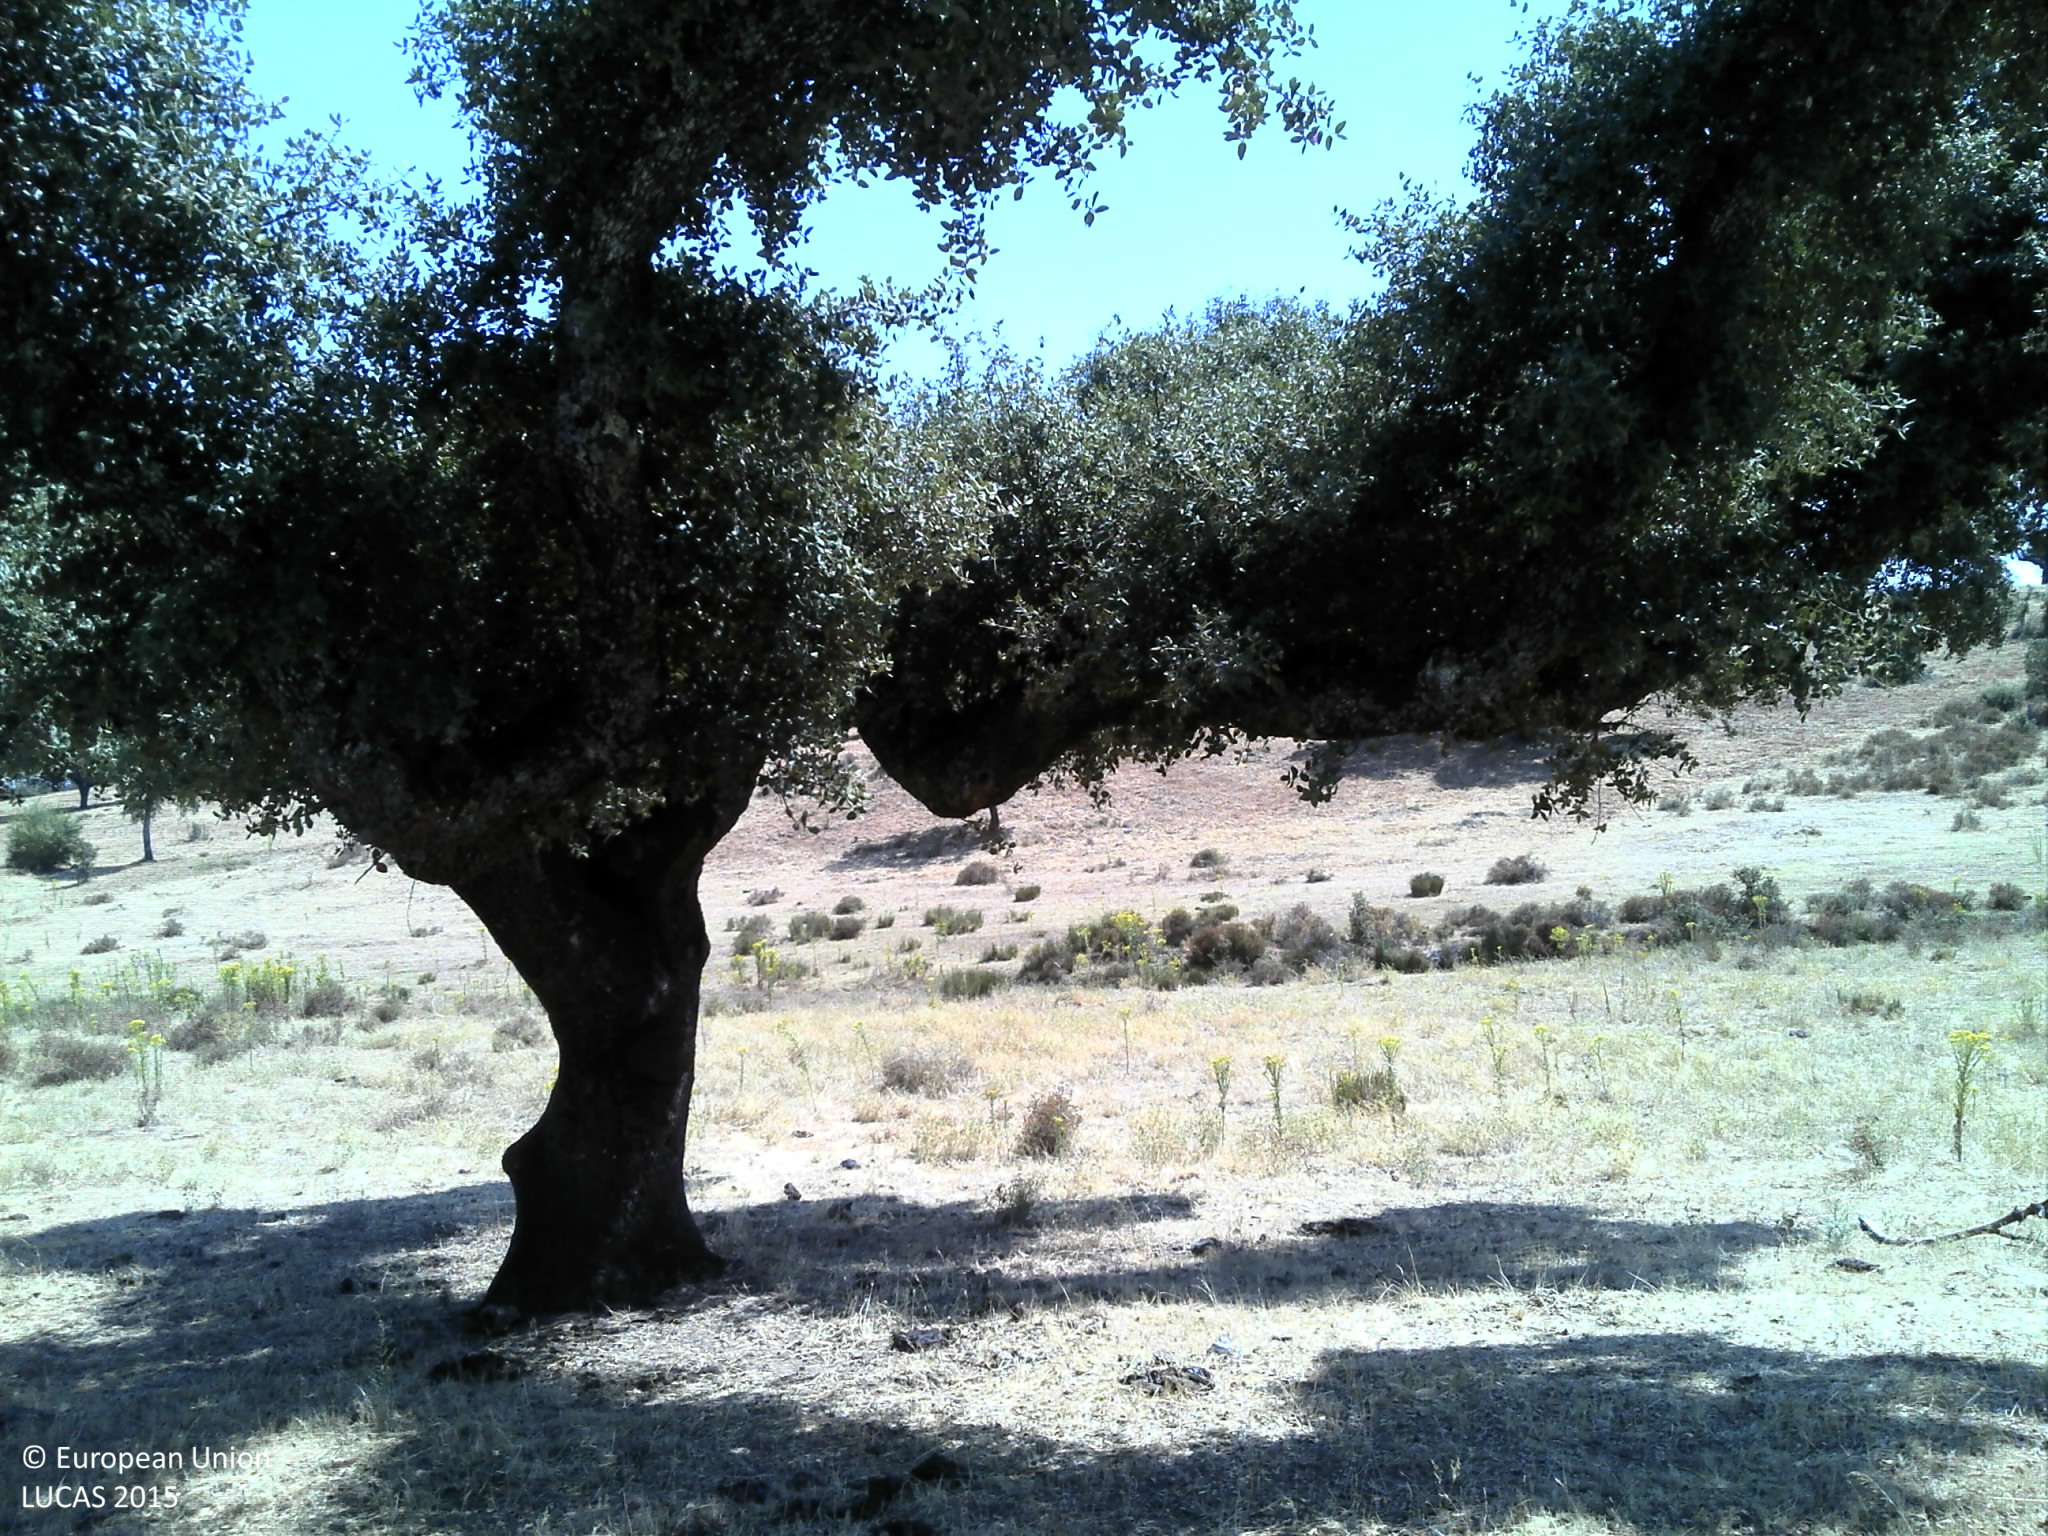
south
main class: Woodland
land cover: Broadleaved woodland
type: broadleaved evergreen forest
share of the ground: 25 - 50 %
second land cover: Grassland without tree/shrub cover
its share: 10 - 25 %
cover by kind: unconsolidated bare surface 50 %, broadleaved forest trees 25 %, herbaceous plants 25 %
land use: Forestry
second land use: Agriculture (excluding fallow land and kitchen gardens)
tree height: > 5 m
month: July
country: PT
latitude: 38.6777
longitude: -7.5157
